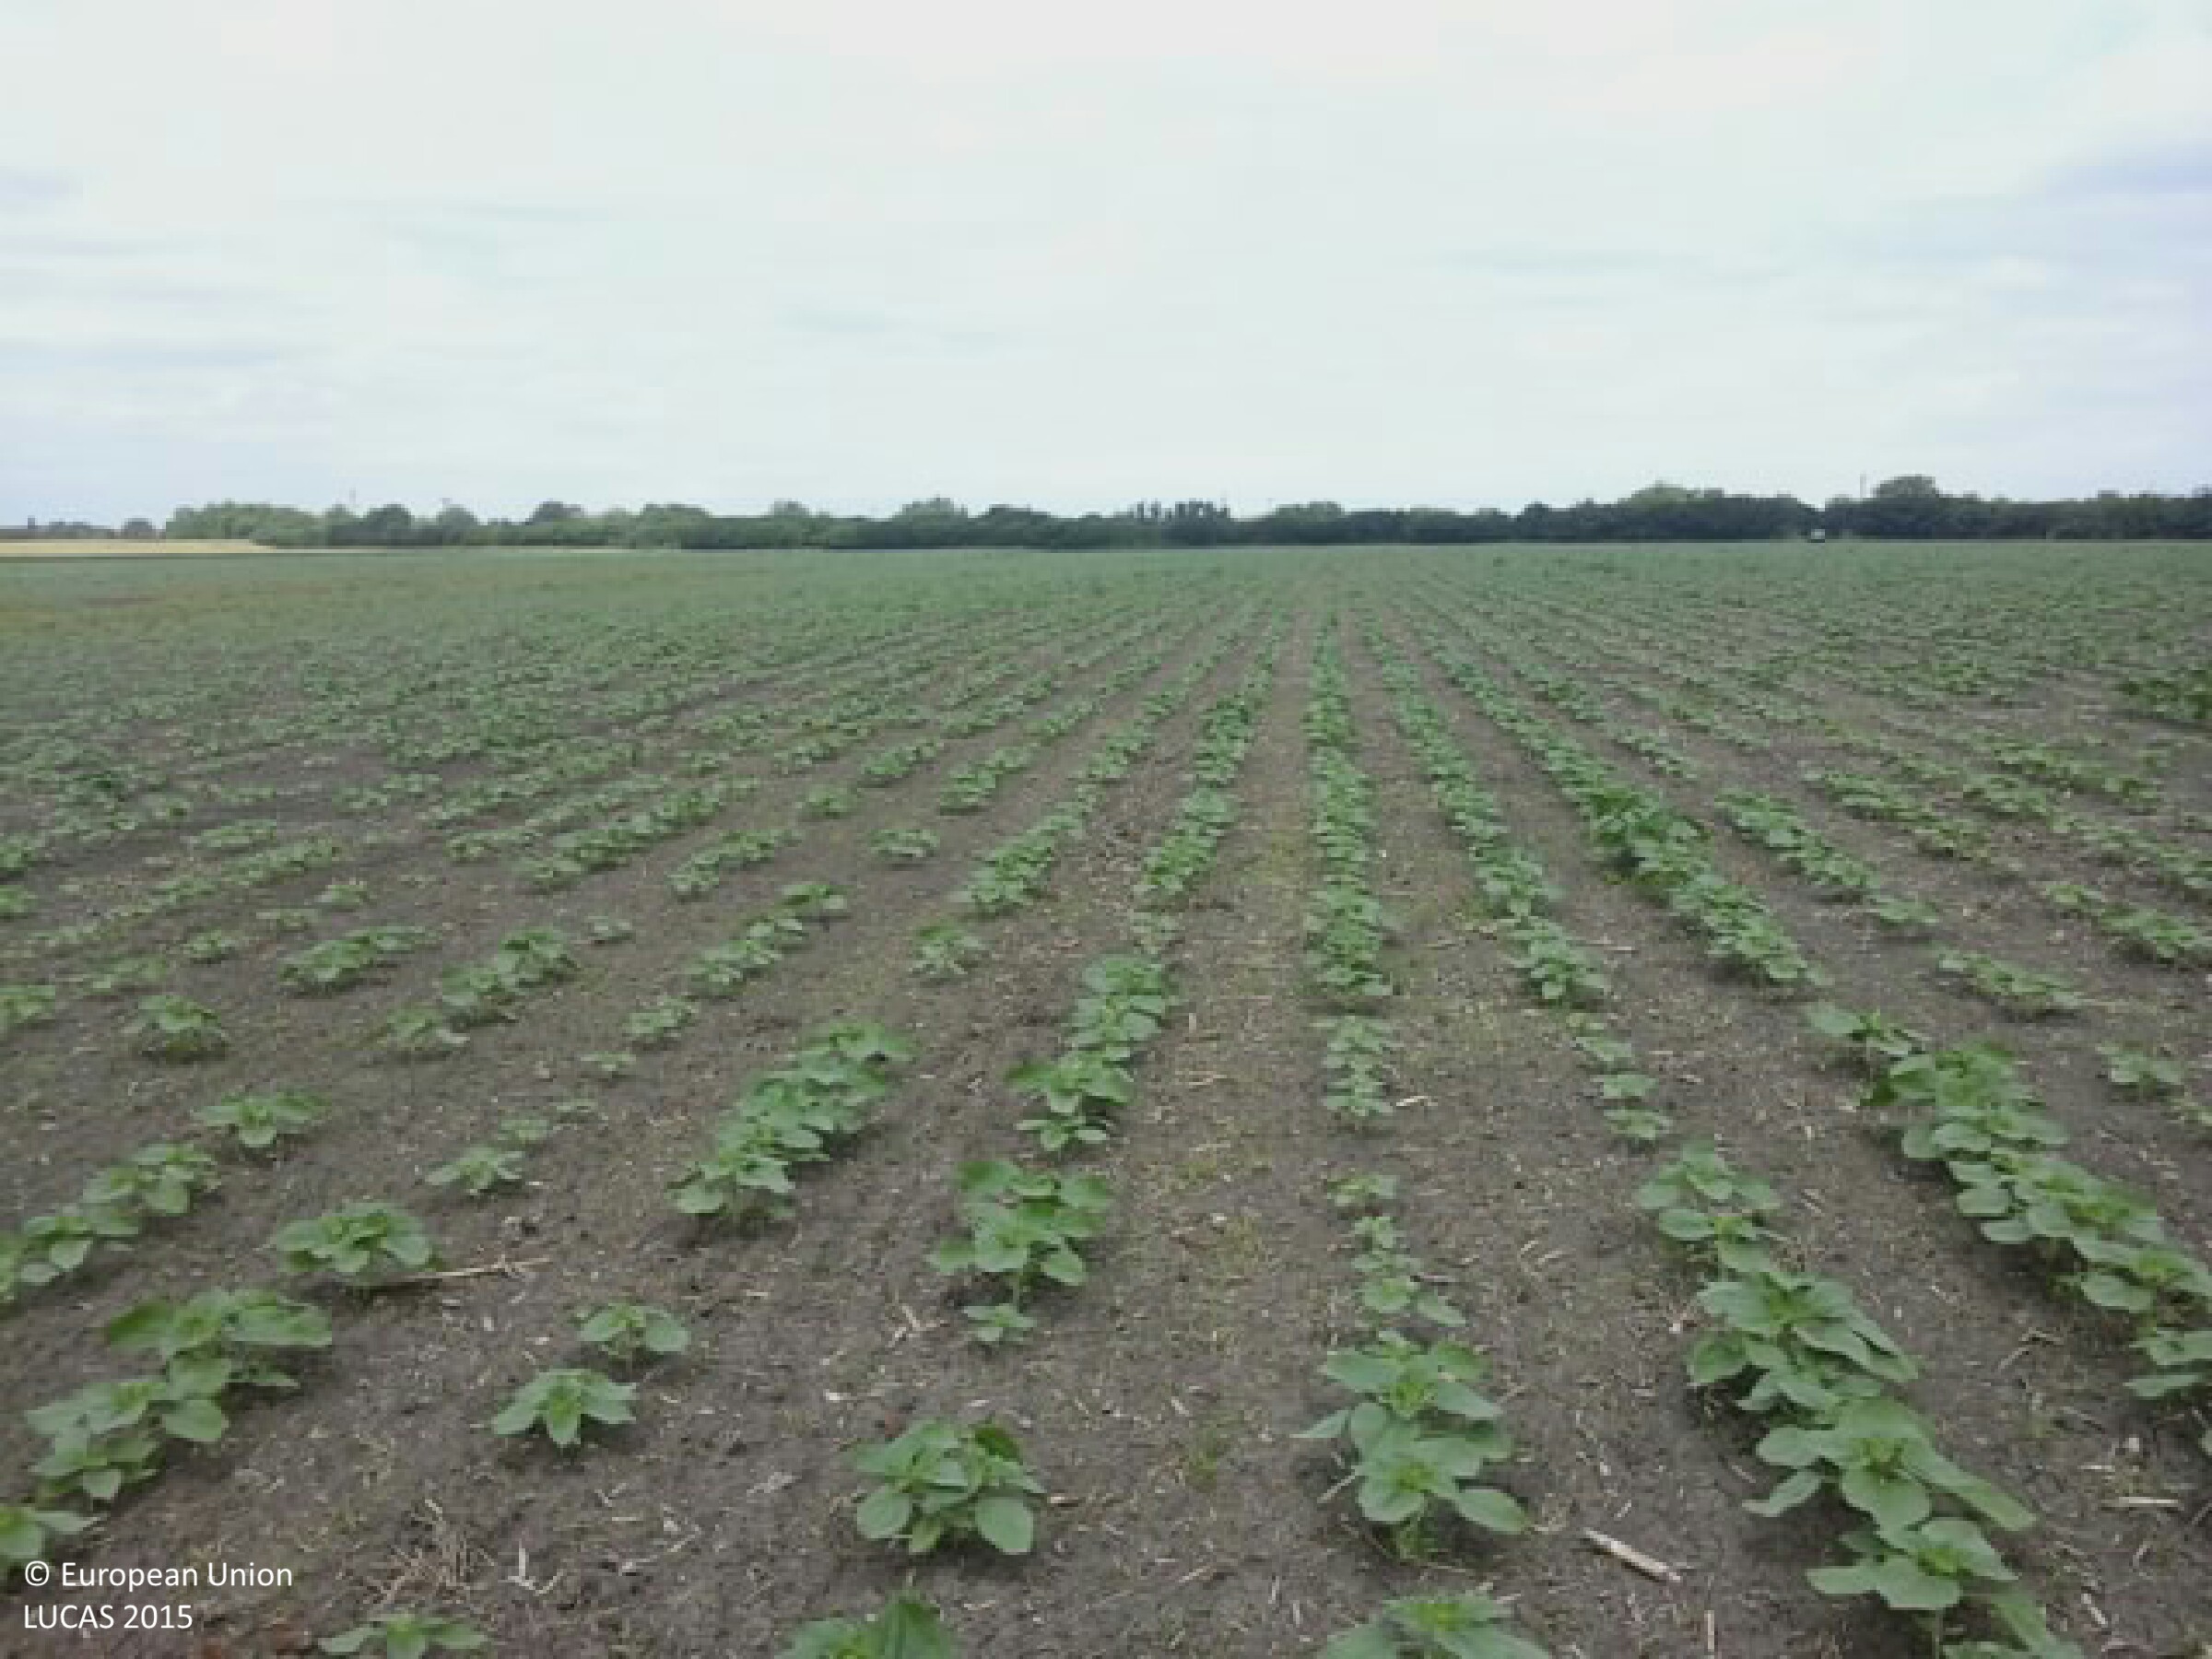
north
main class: Cropland
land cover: Sunflower
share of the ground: 10 - 25 %
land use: Agriculture (excluding fallow land and kitchen gardens)
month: June
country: HU
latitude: 46.1687
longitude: 20.0323
